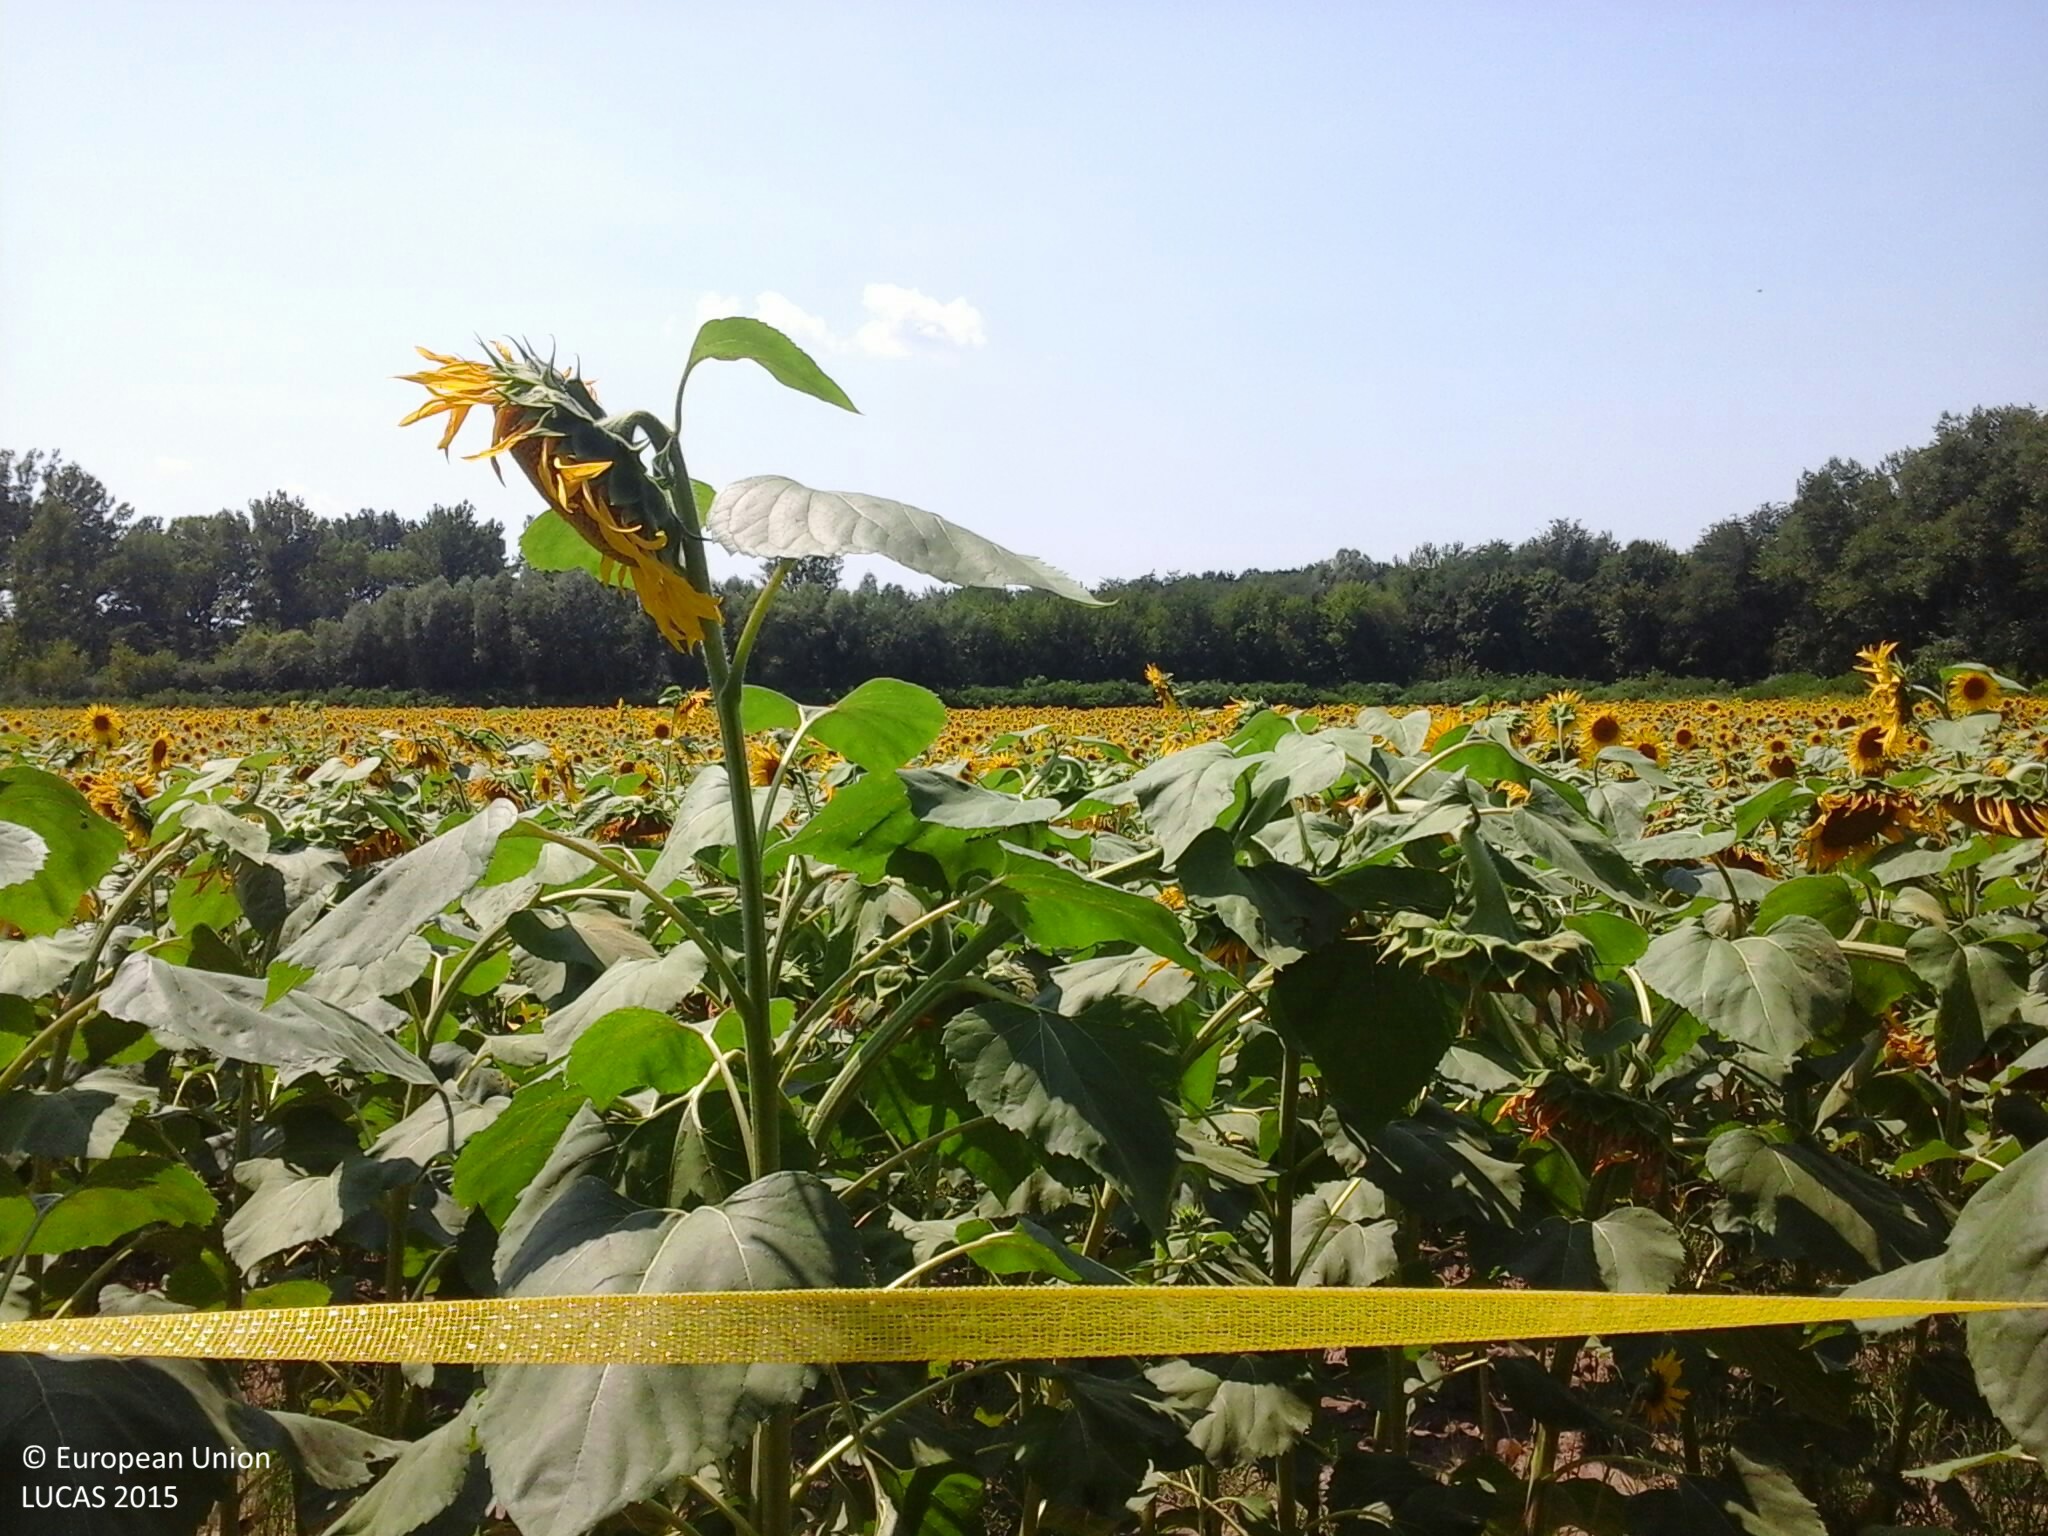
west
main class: Cropland
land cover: Sunflower
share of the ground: > 75 %
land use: Agriculture (excluding fallow land and kitchen gardens)
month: July
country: HU
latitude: 46.6523
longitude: 17.1777
